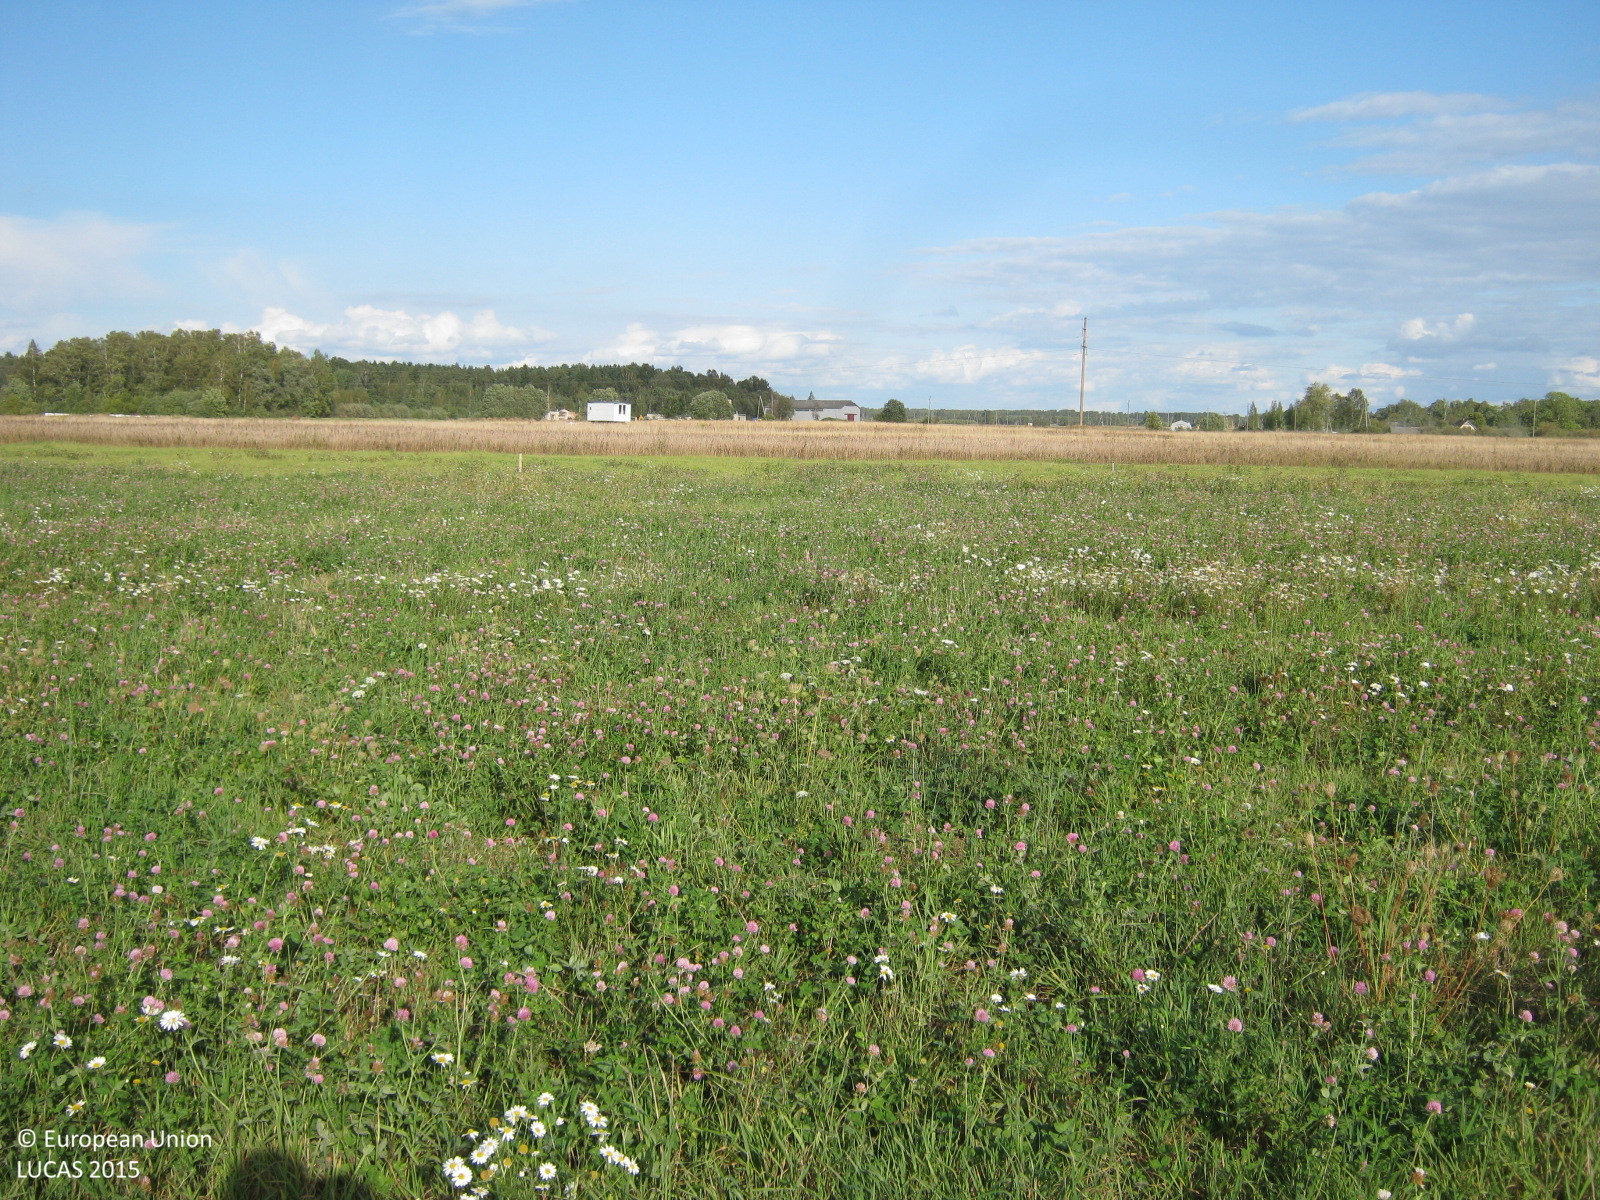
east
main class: Cropland
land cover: Clovers
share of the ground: > 75 %
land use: Agriculture (excluding fallow land and kitchen gardens)
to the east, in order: Clovers; Grassland without tree/shrub cover; Fences; Grassland without tree/shrub cover; Dry pulses; Grassland without tree/shrub cover; Spontaneously vegetated surfaces
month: September
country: LV
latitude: 57.3360
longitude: 24.4951
